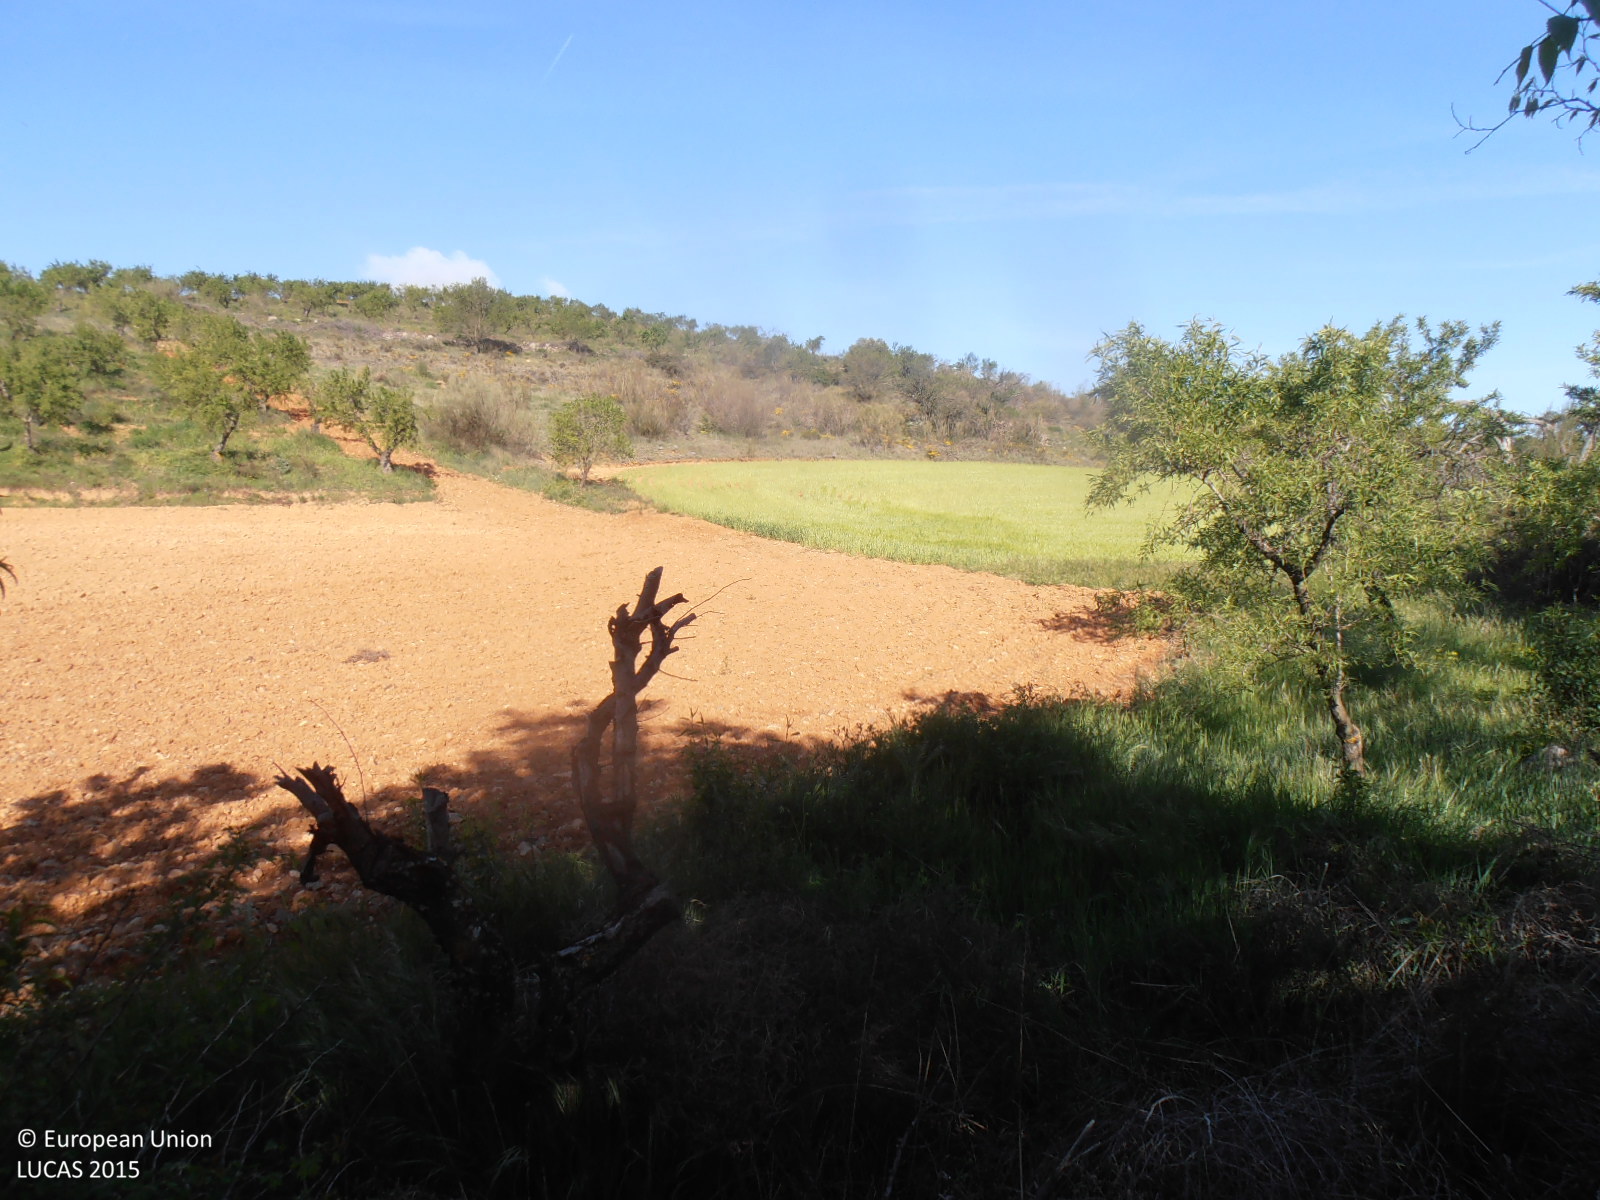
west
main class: Woodland
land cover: Broadleaved woodland
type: thermophilous deciduous forest
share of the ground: > 75 %
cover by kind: broadleaved forest trees 90 %, shrubs 10 %
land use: Semi-natural and natural areas not in use
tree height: < 5 m
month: April
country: ES
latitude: 41.2351
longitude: -0.9832
